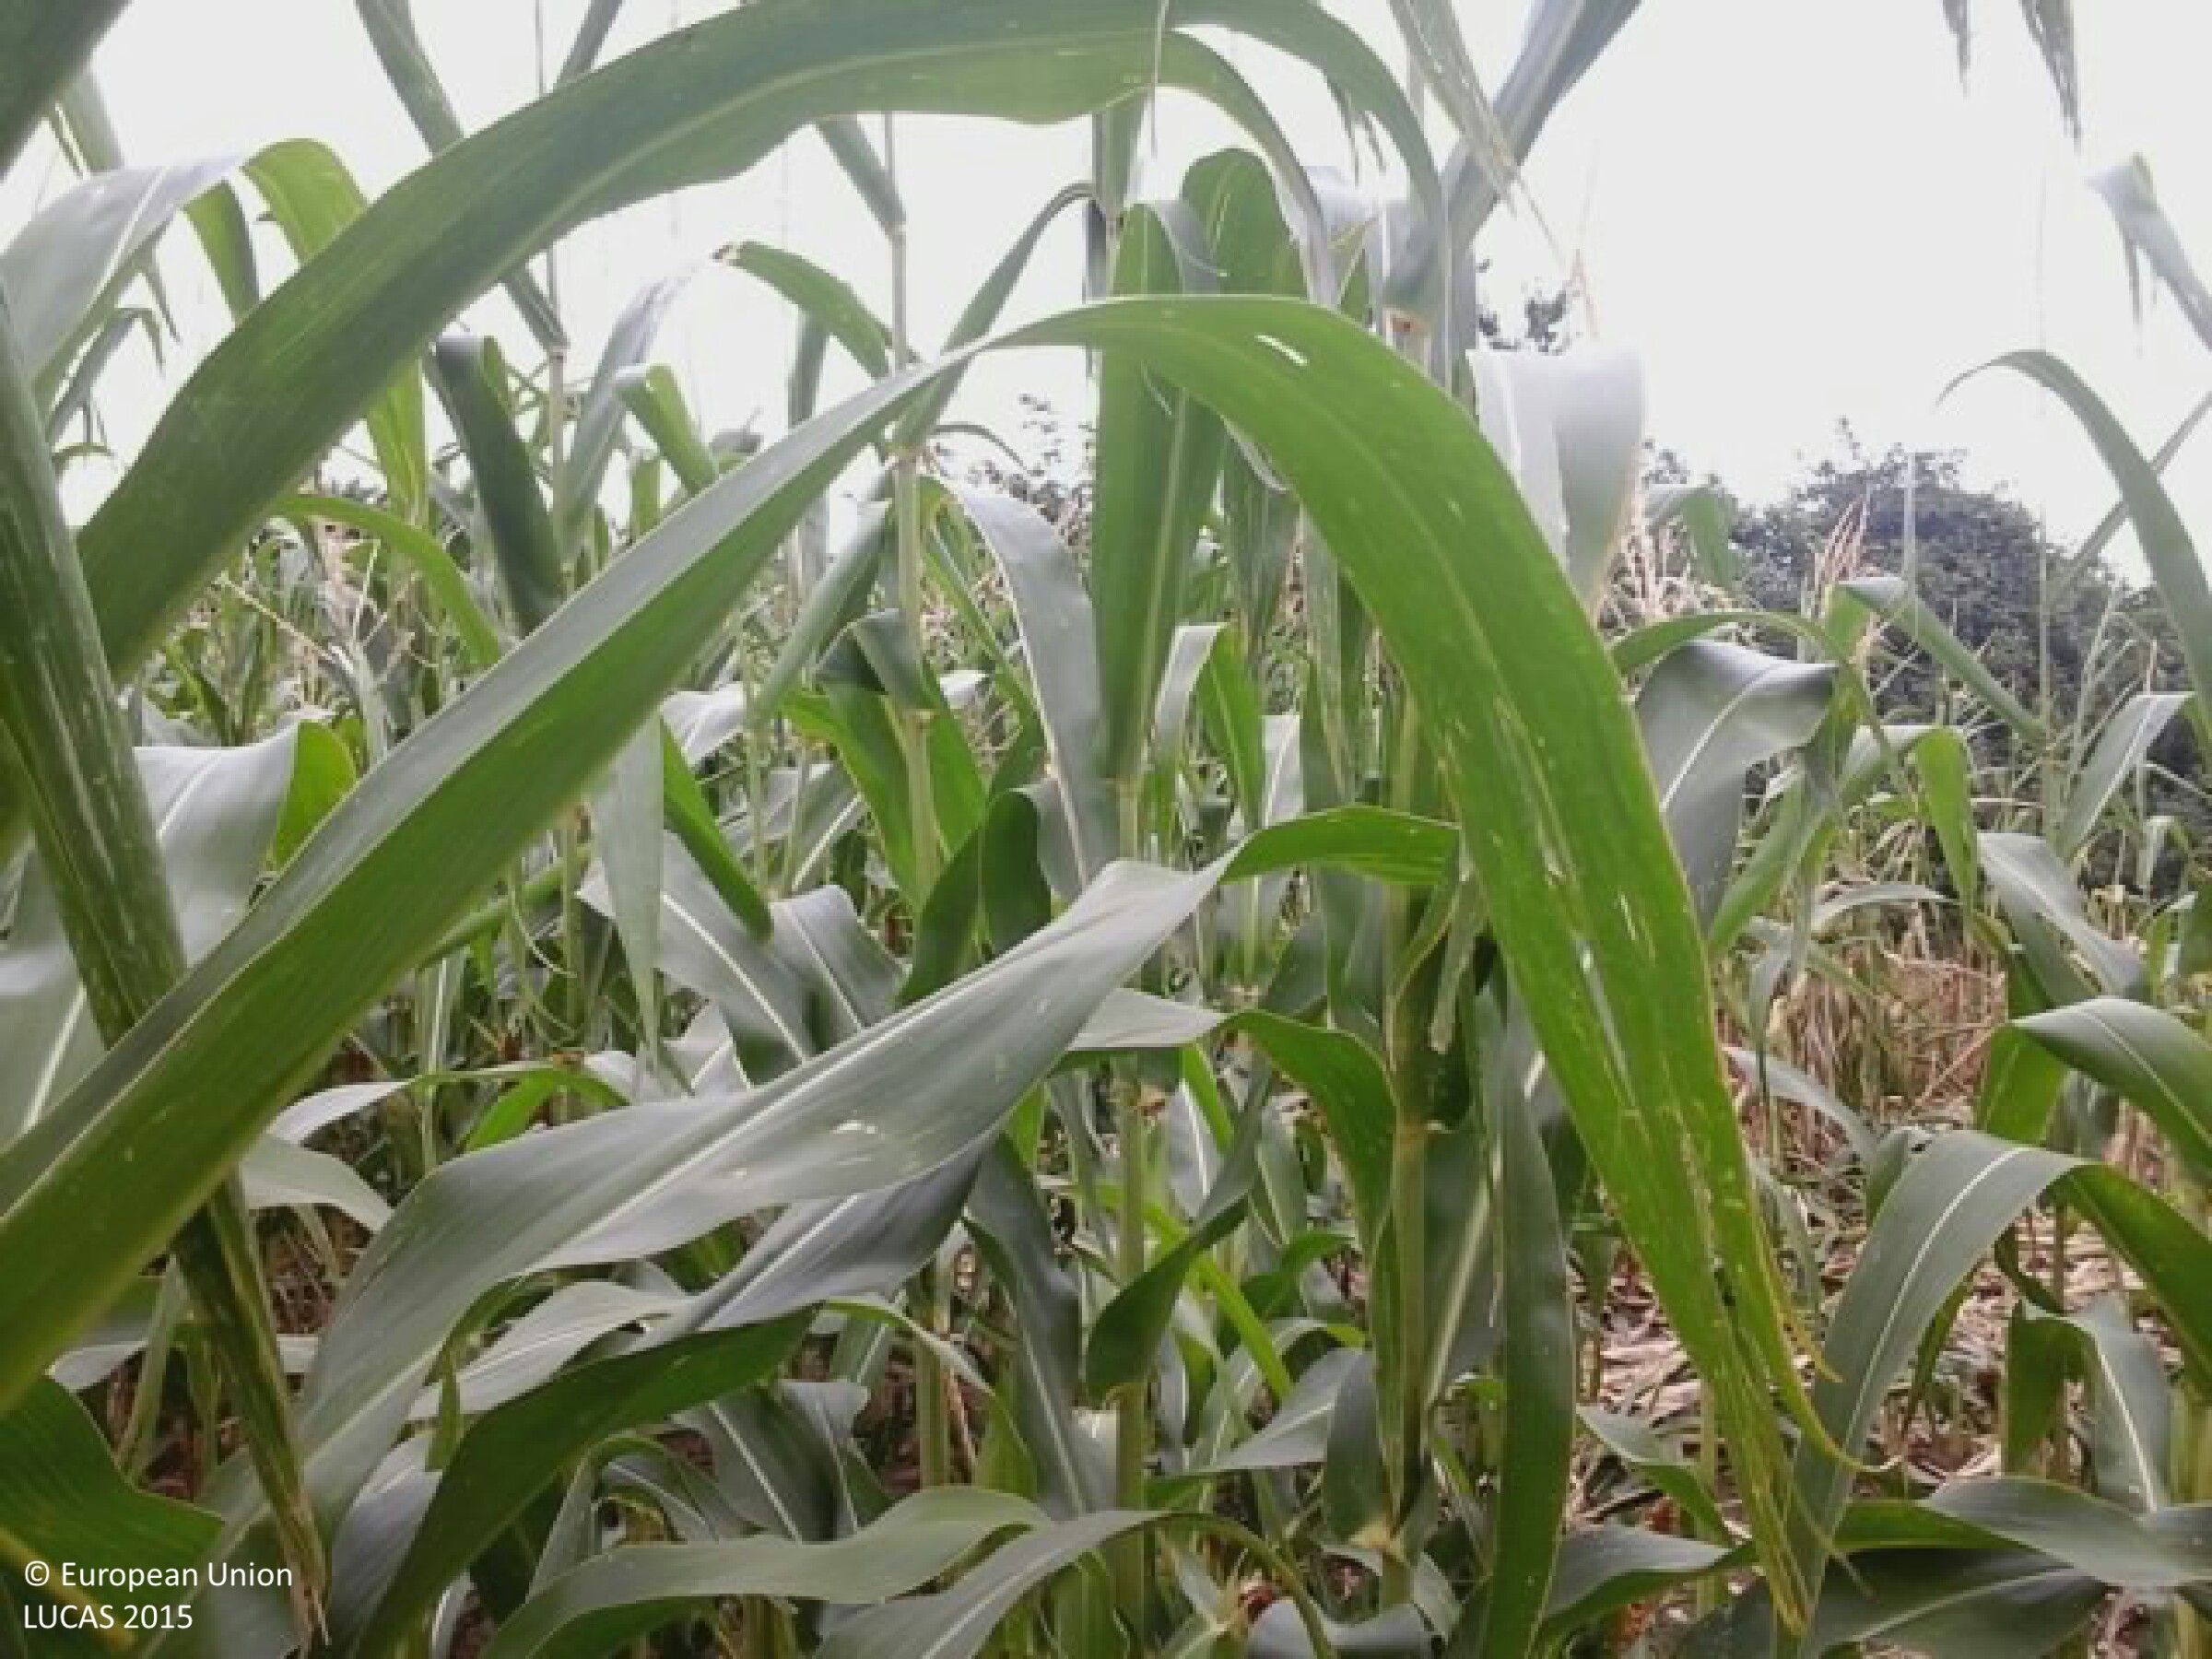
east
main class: Cropland
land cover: Maize
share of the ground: > 75 %
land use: Agriculture (excluding fallow land and kitchen gardens)
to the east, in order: Maize; Shrubland with sparse tree cover; Broadleaved woodland; Shrubland with sparse tree cover; Maize
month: July
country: HU
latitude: 46.1483
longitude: 18.3850
